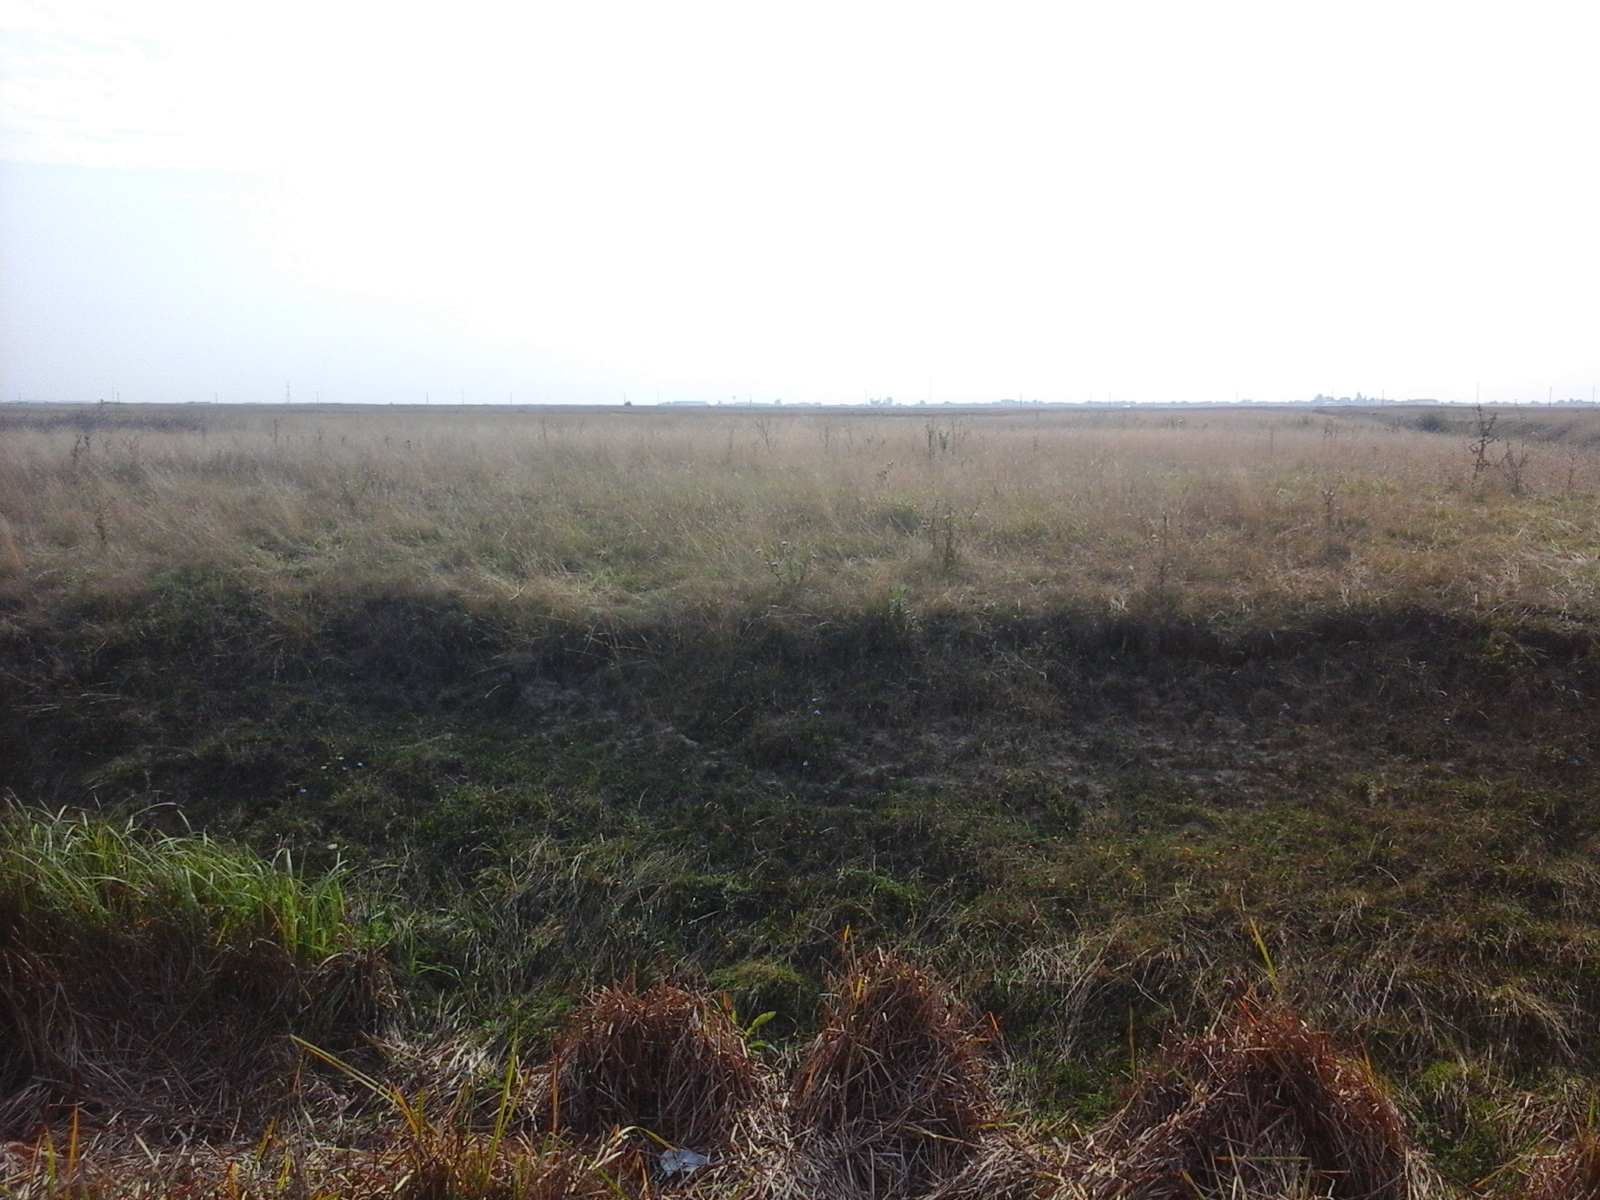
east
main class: Grassland
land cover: Grassland without tree/shrub cover
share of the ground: > 75 %
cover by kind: herbaceous plants 100 %
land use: Agriculture (excluding fallow land and kitchen gardens)
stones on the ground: < 10 %
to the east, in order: Grassland without tree/shrub cover; Ditches and canals; Grassland without tree/shrub cover
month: August
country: RO
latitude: 46.7422
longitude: 21.5443
